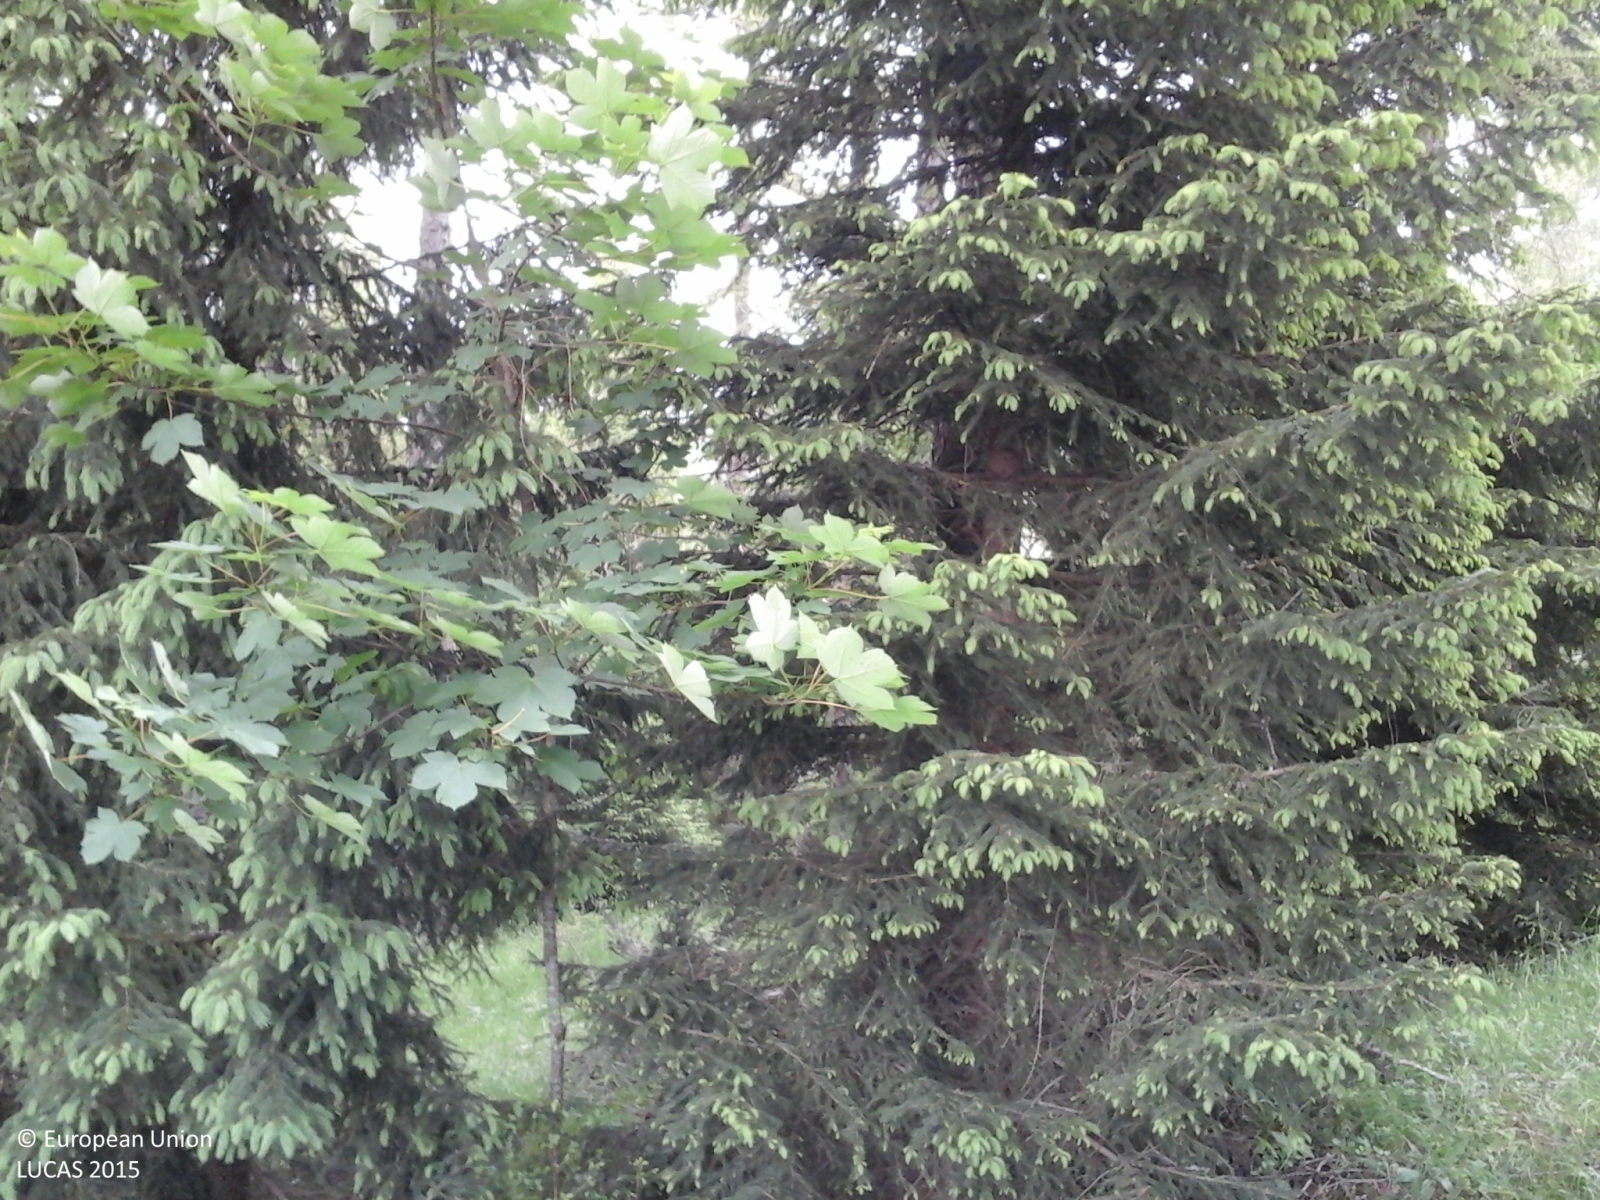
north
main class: Woodland
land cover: Spruce dominated coniferous woodland
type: alpine coniferous forest
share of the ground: > 75 %
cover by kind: coniferous forest trees 100 %
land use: Forestry
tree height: > 5 m
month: June
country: IT
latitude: 45.8944
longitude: 11.1710
